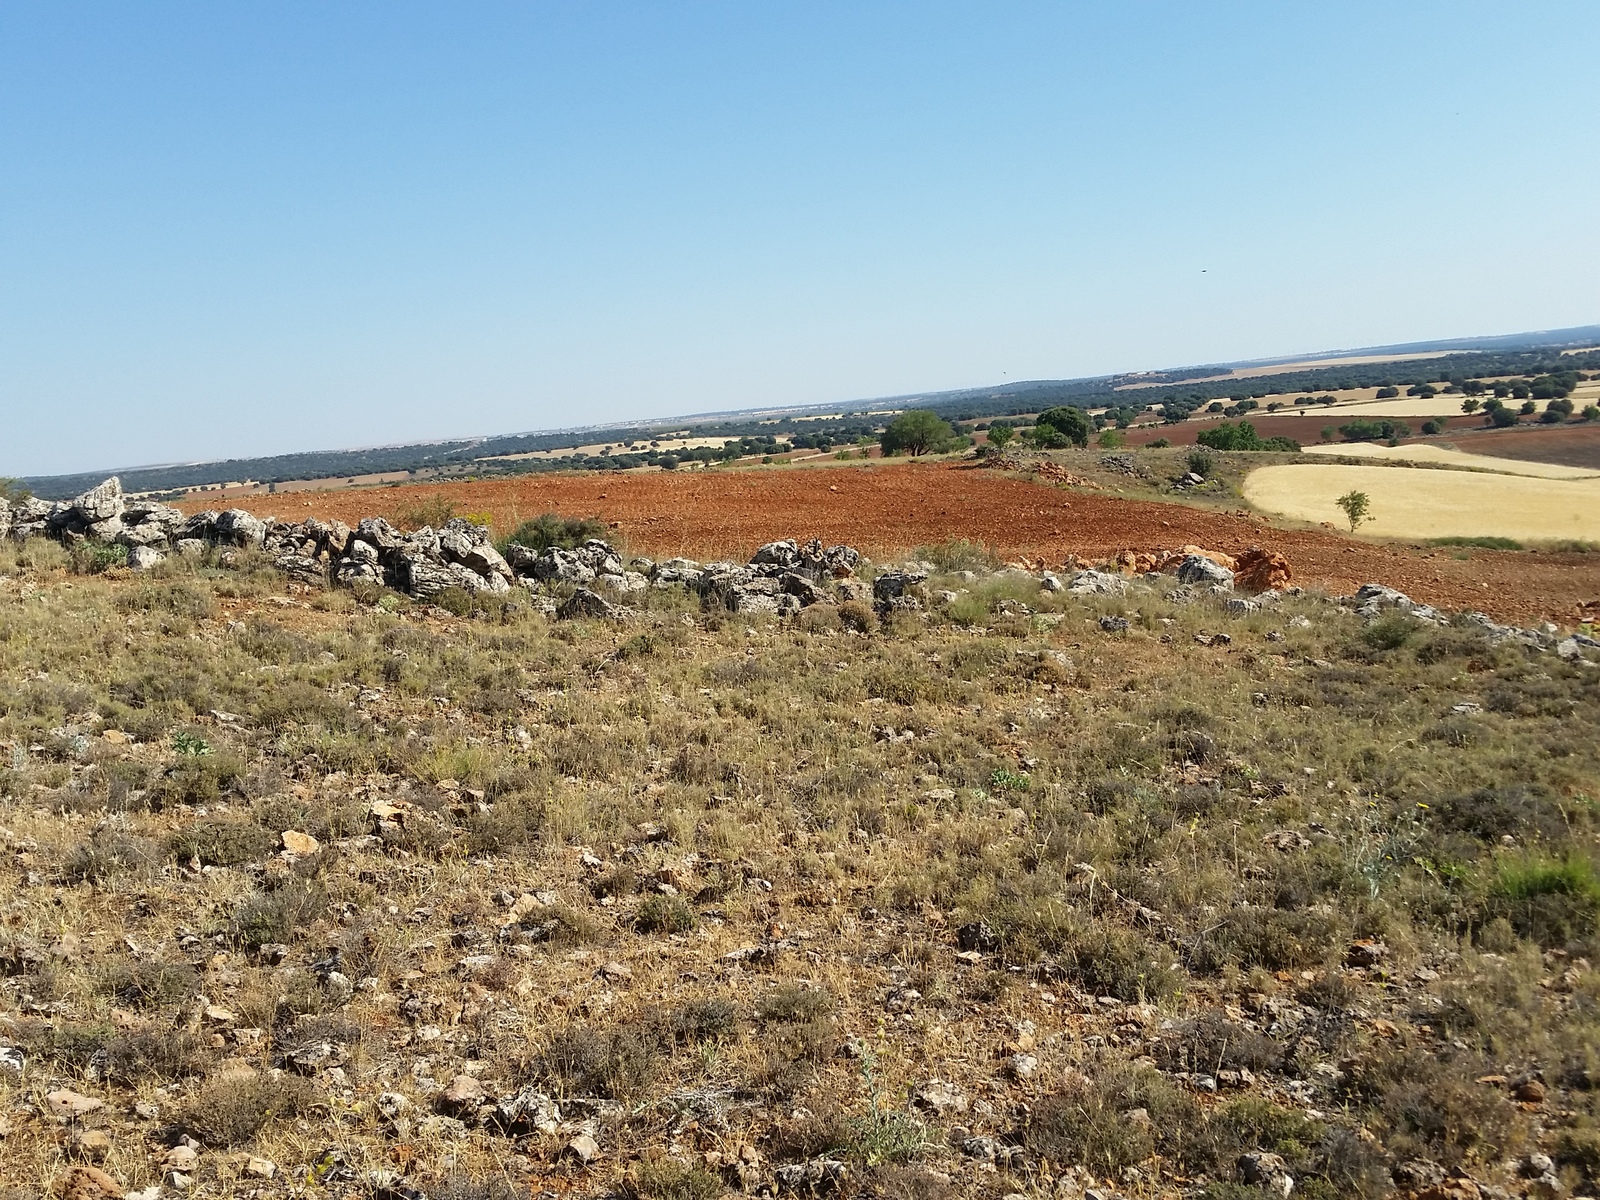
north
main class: Shrubland
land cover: Shrubland without tree cover
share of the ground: > 75 %
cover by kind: shrubs 60 %, consolidated bare surface 25 %, herbaceous plants 15 %
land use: Semi-natural and natural areas not in use
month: June
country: ES
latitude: 38.7586
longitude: -2.4418
